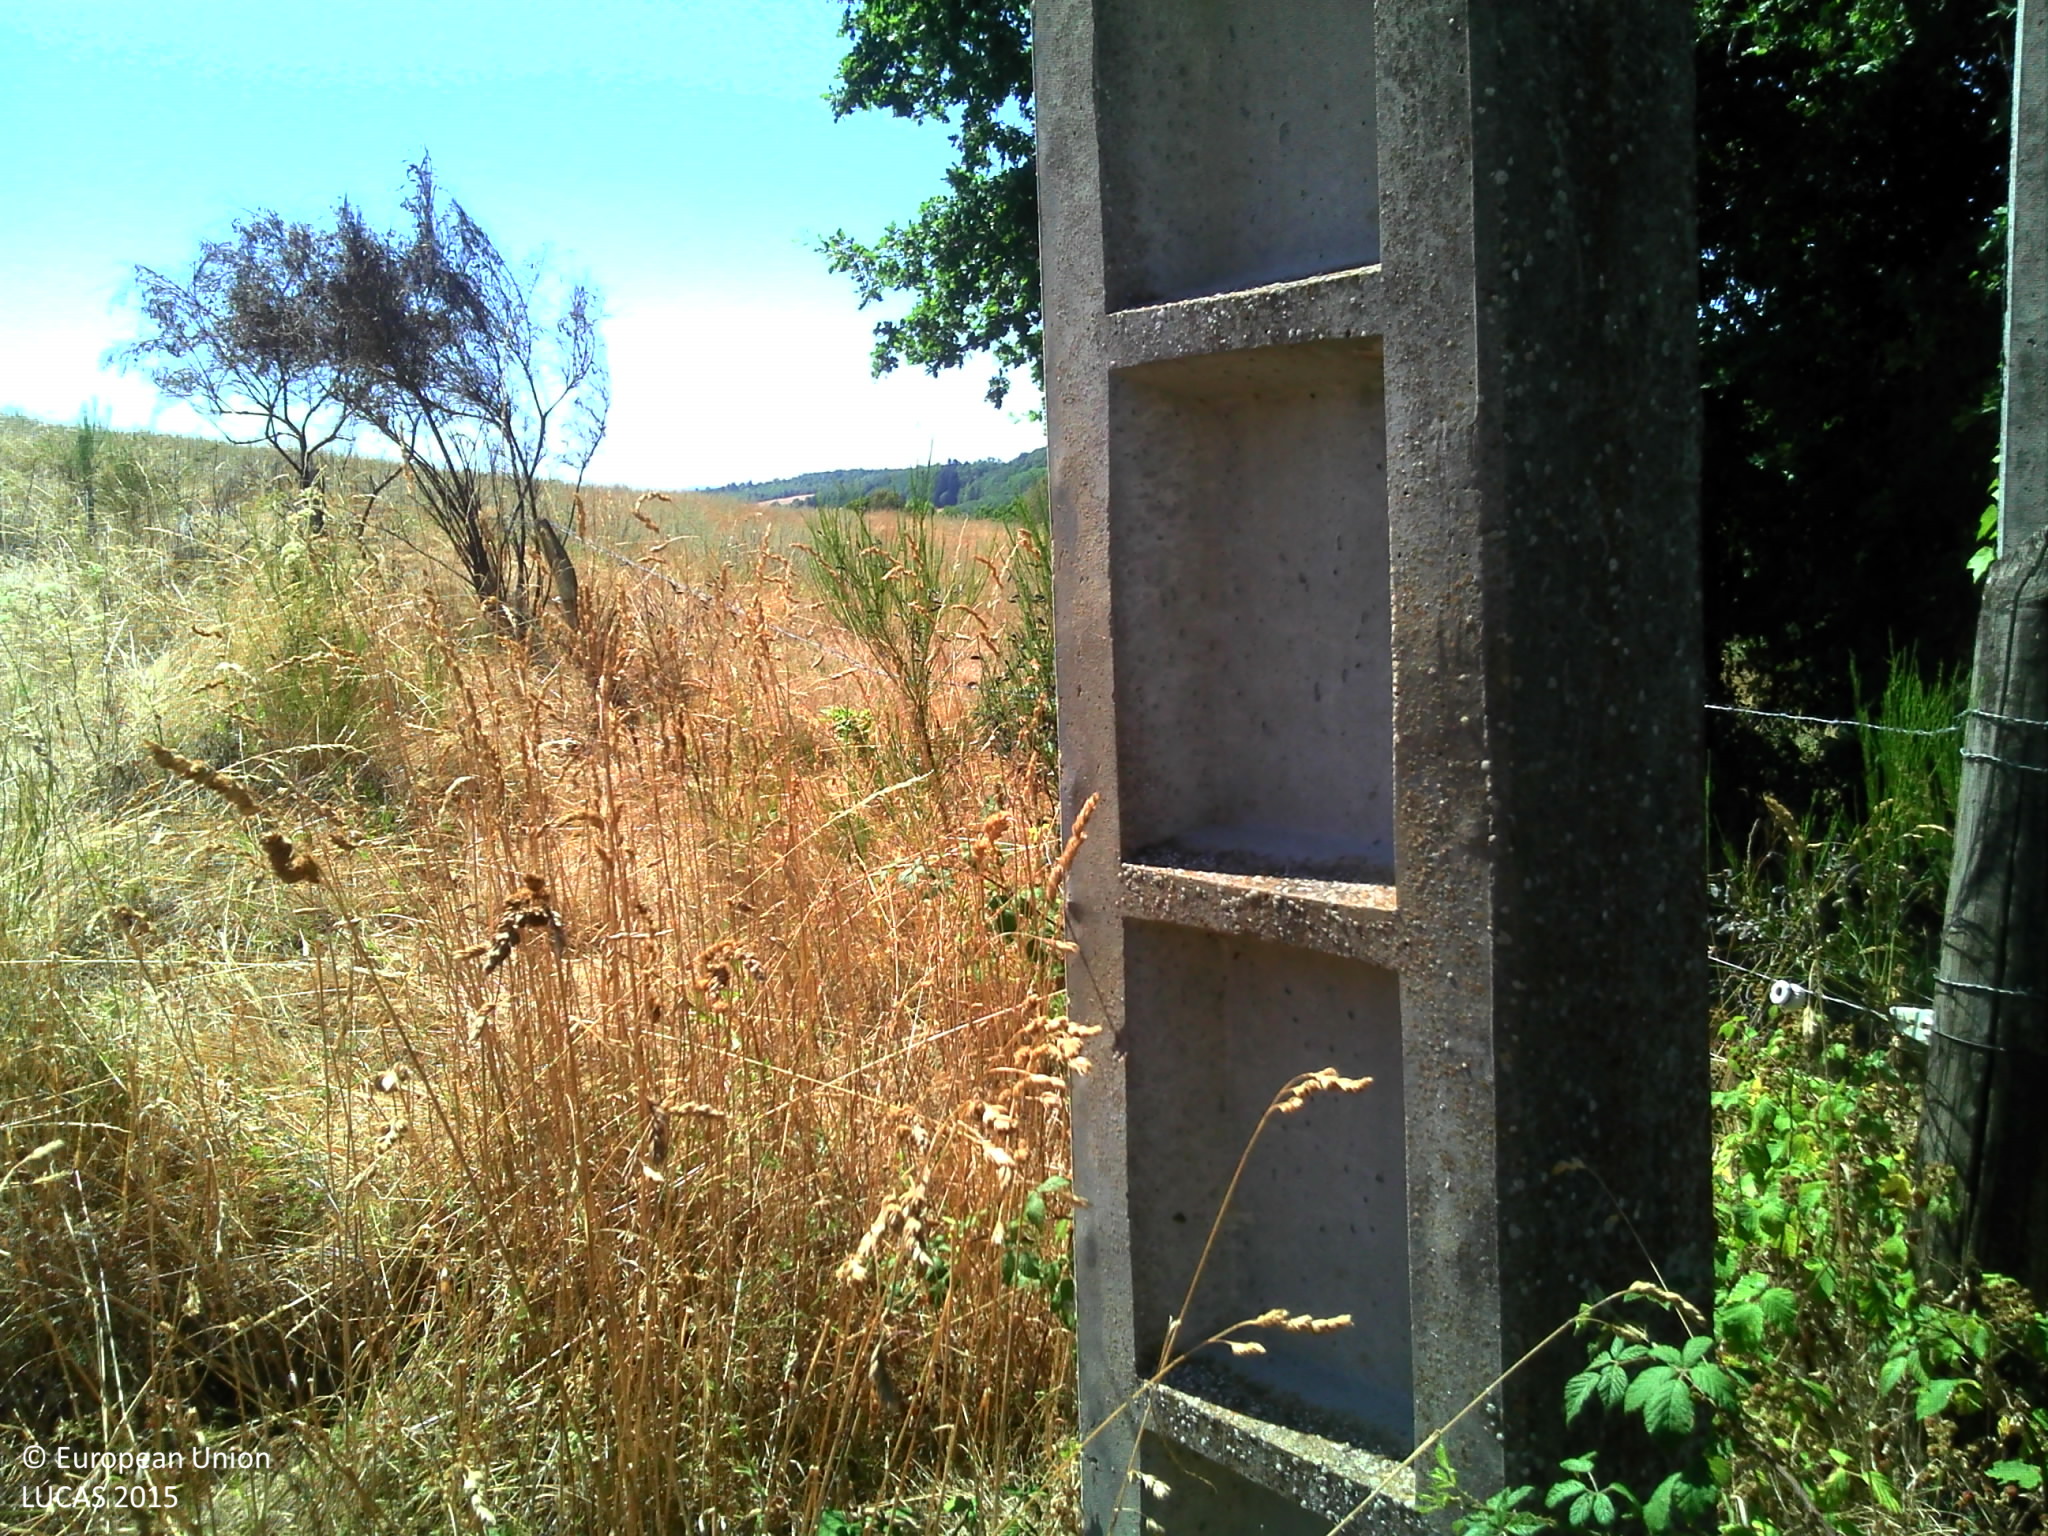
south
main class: Woodland
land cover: Broadleaved woodland
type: mesophytic deciduous forest
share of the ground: > 75 %
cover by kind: broadleaved forest trees 80 %, herbaceous plants 20 %
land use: Semi-natural and natural areas not in use
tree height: < 5 m
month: July
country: FR
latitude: 45.9413
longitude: 4.5465
